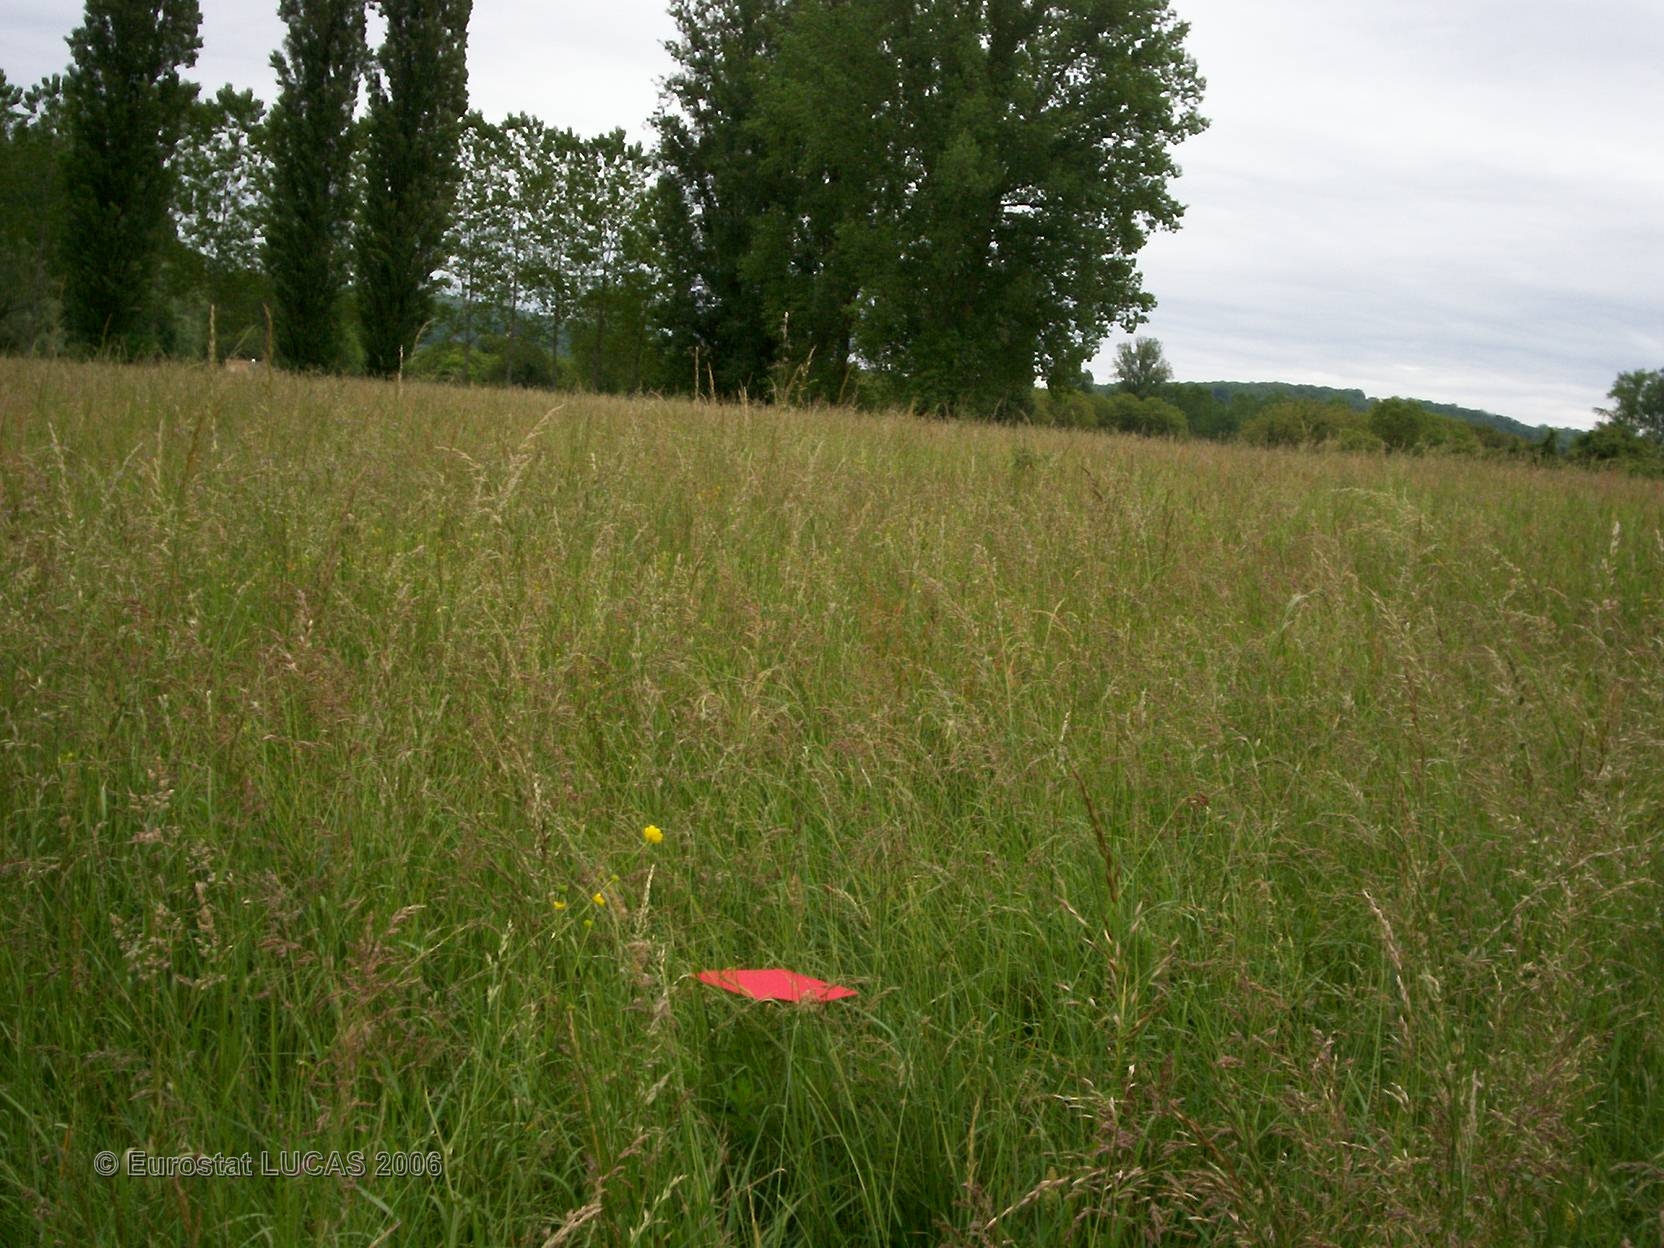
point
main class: Grassland
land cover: Grassland without tree/shrub cover
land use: Agriculture (excluding fallow land and kitchen gardens)
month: May
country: FR
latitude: 44.8591
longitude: 1.3524
